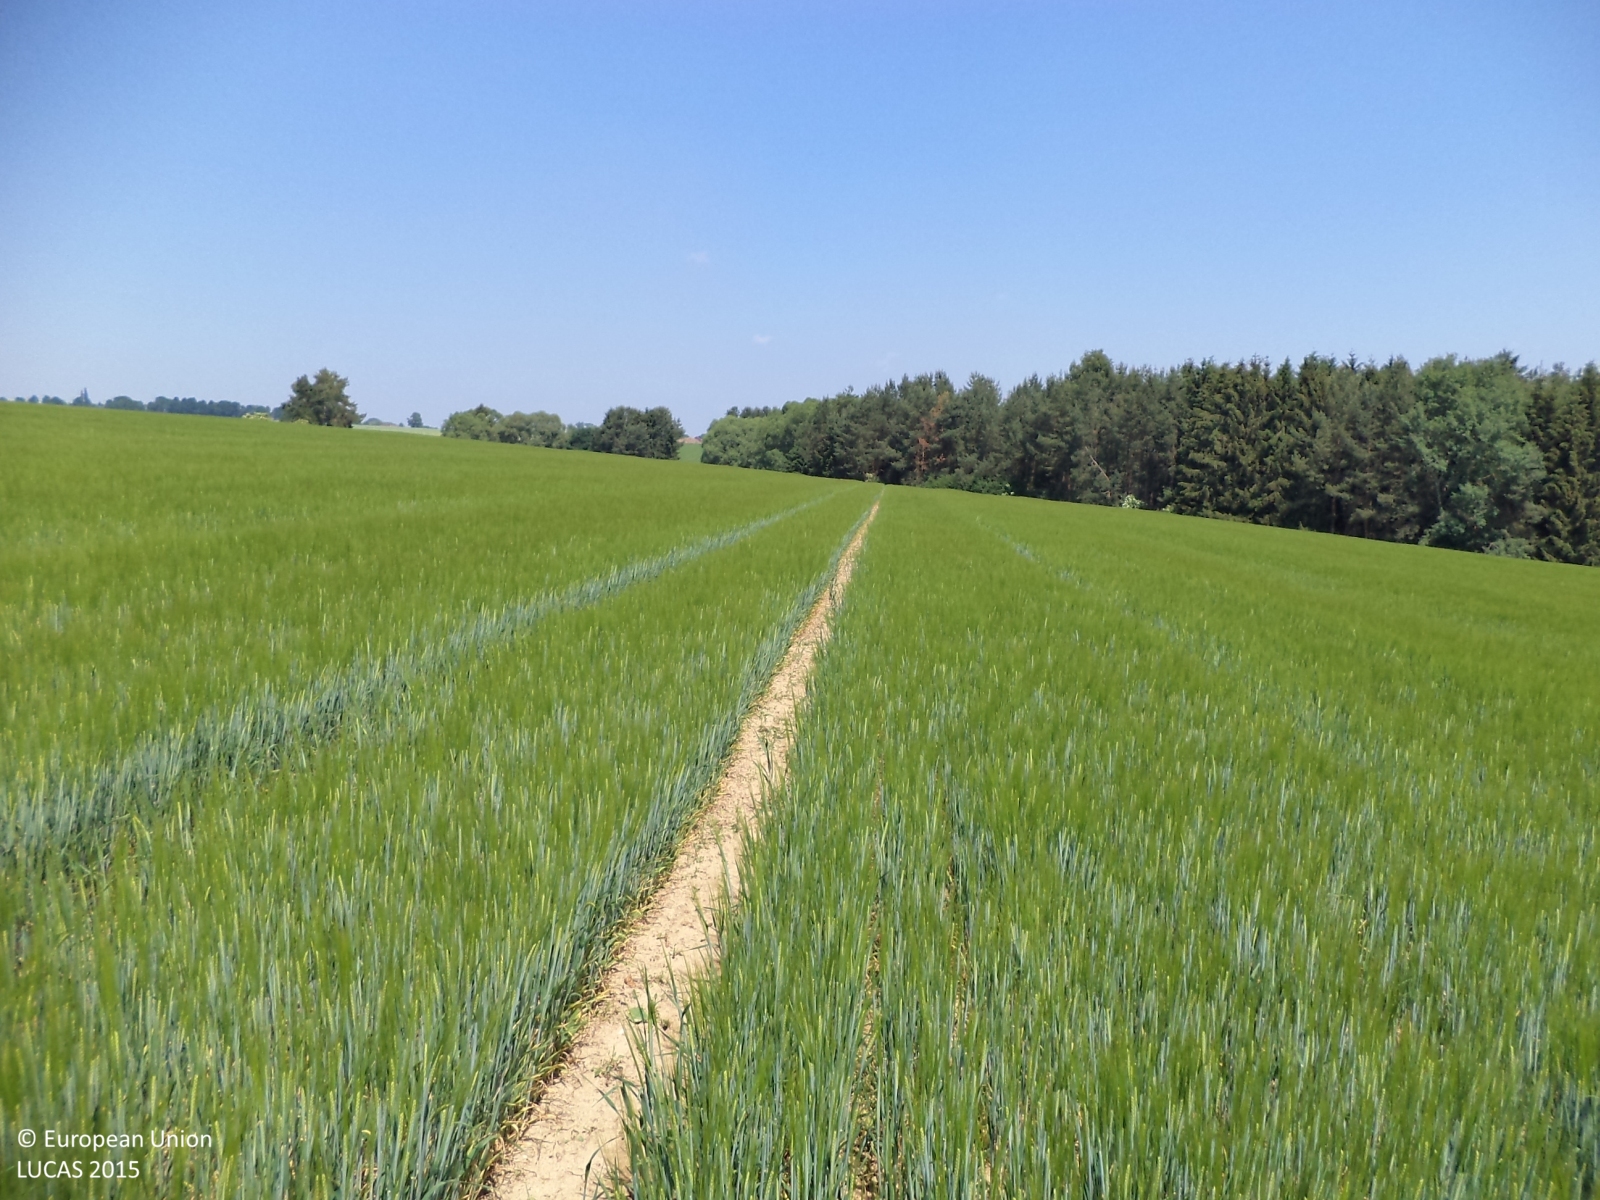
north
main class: Cropland
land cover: Barley
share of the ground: > 75 %
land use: Agriculture (excluding fallow land and kitchen gardens)
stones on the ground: < 10 %
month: June
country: CZ
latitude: 49.3052
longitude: 14.4436
